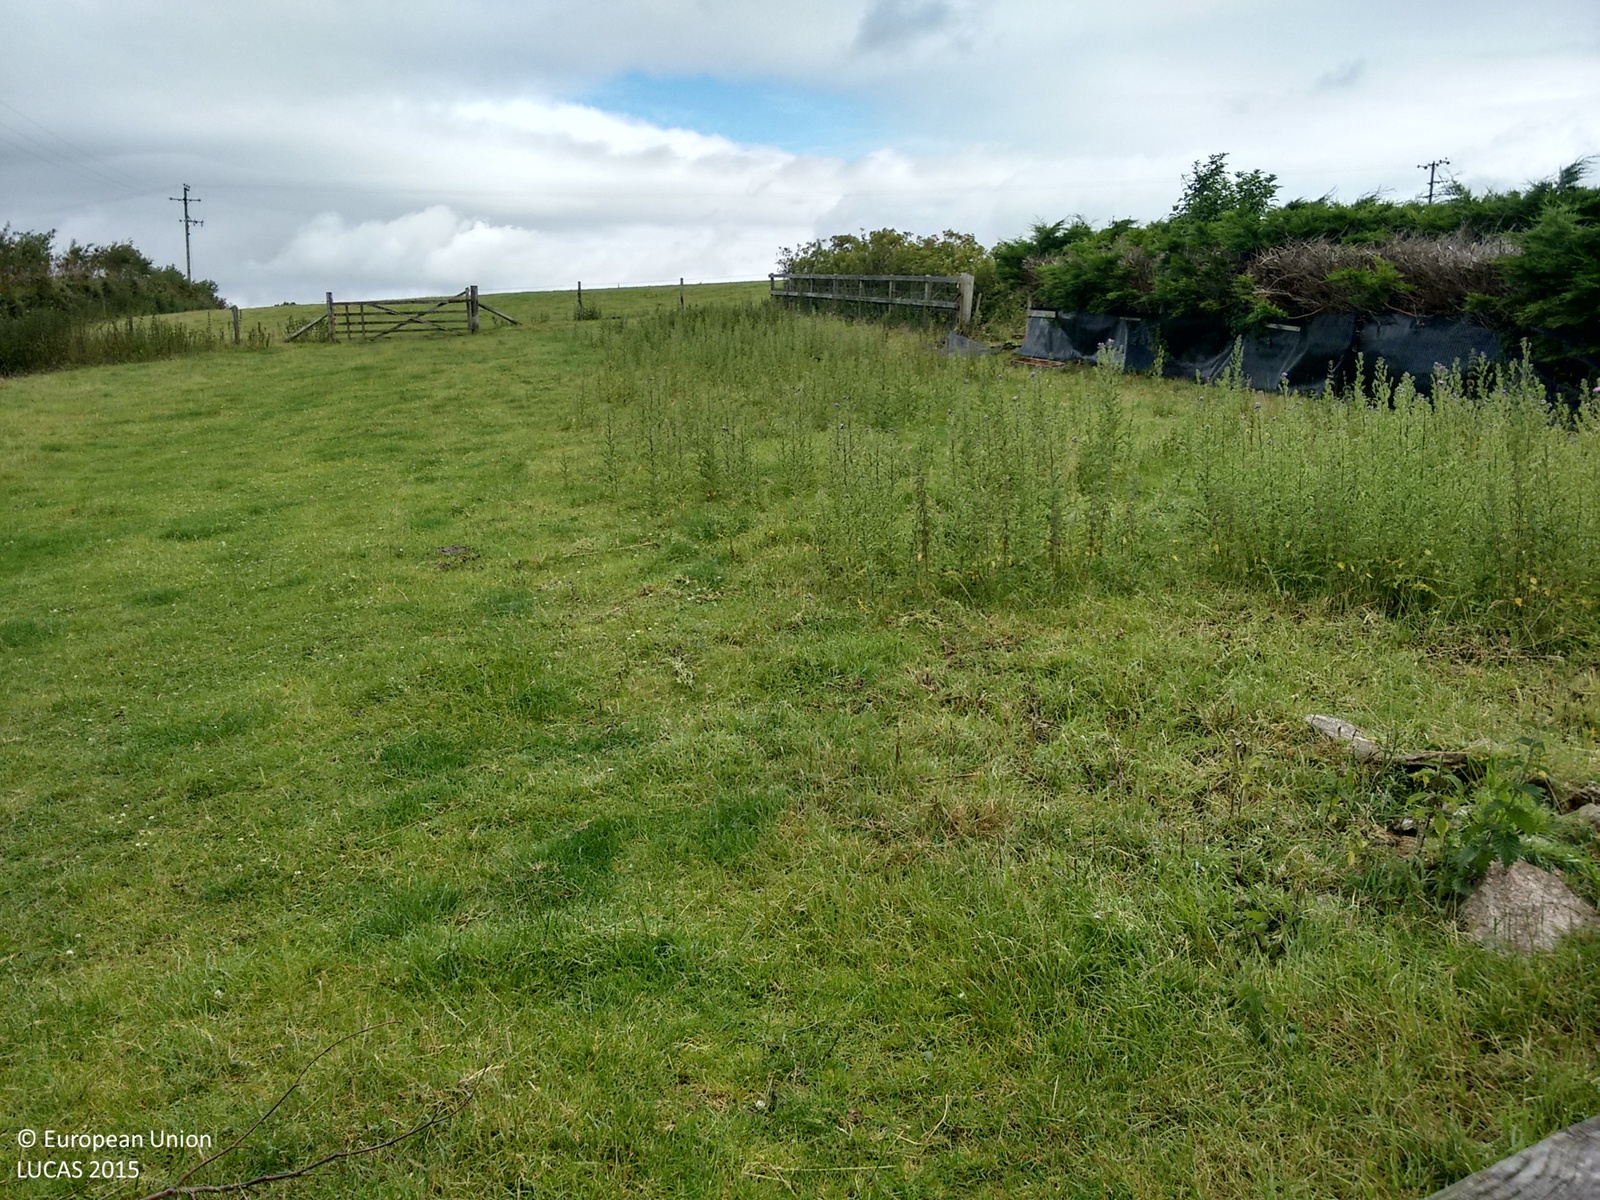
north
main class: Grassland
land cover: Grassland without tree/shrub cover
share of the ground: > 75 %
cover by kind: herbaceous plants 100 %
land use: Agriculture (excluding fallow land and kitchen gardens)
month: July
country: GB
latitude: 51.1415
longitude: -3.5350
